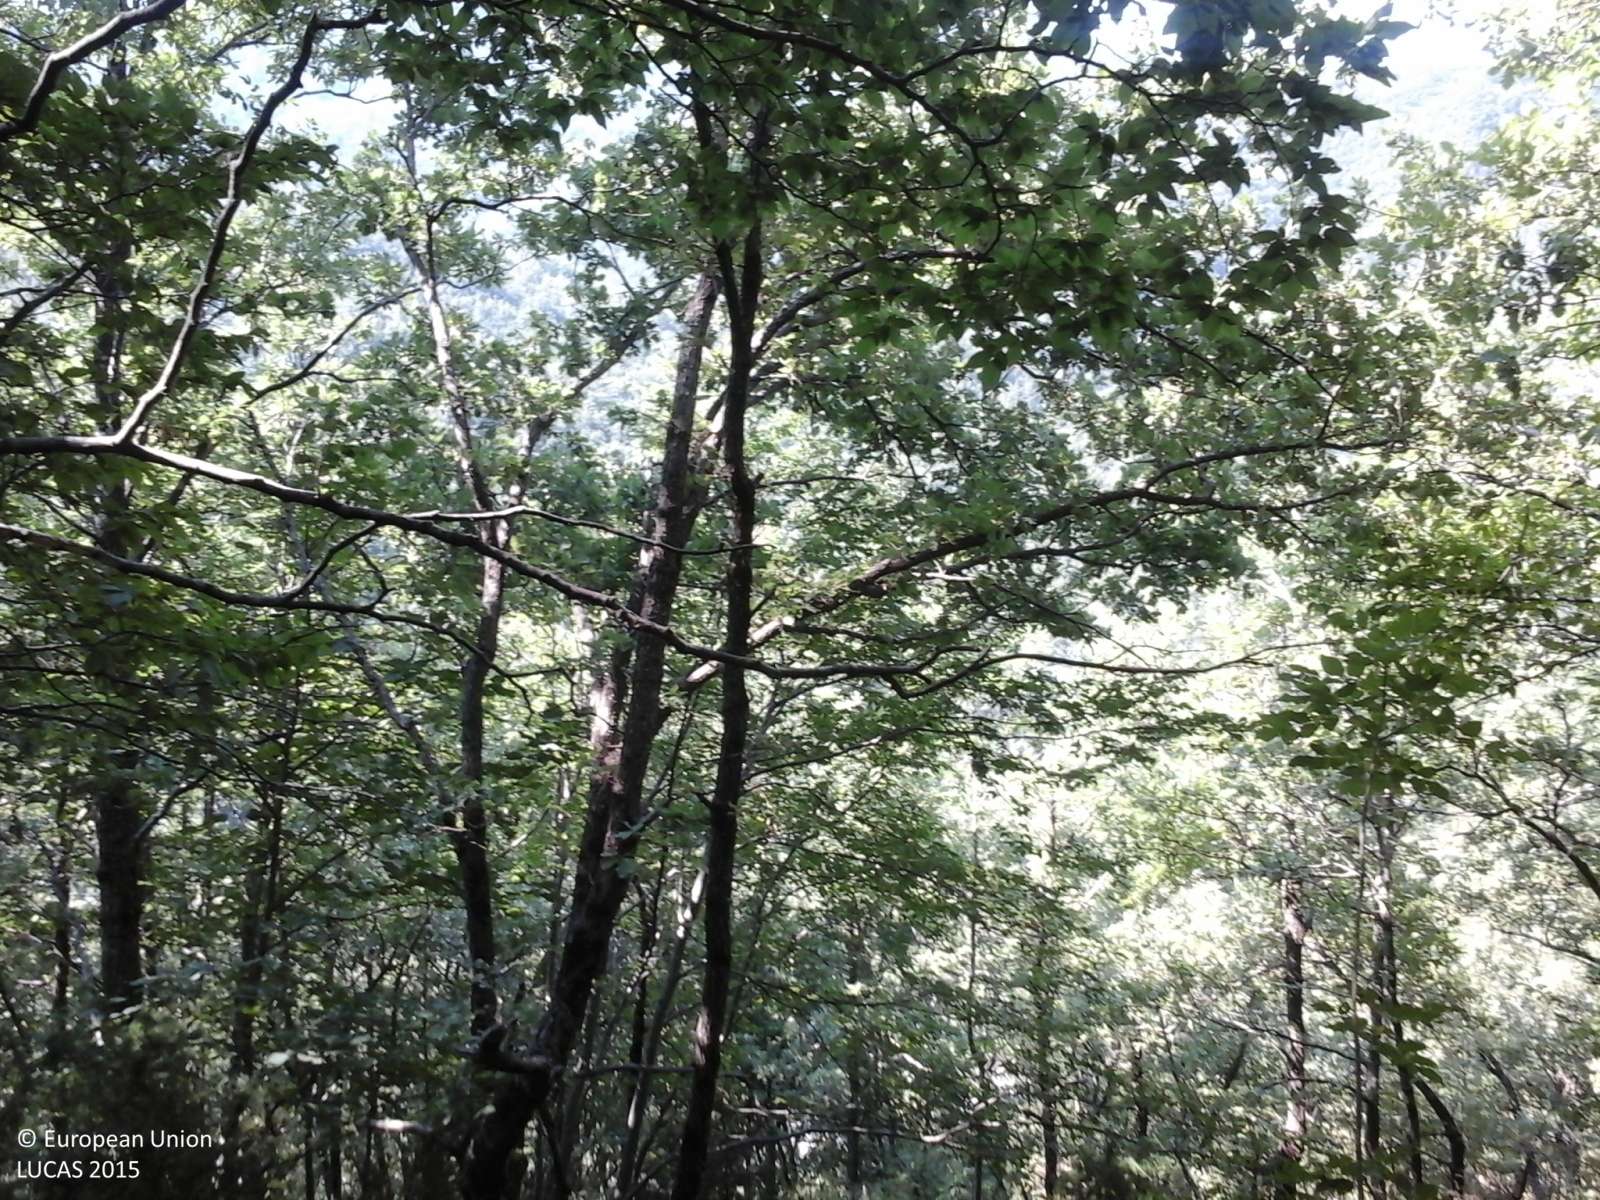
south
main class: Woodland
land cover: Broadleaved woodland
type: thermophilous deciduous forest
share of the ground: > 75 %
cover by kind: broadleaved forest trees 100 %
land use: Forestry
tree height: > 5 m
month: August
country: IT
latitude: 43.6953
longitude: 12.2153
